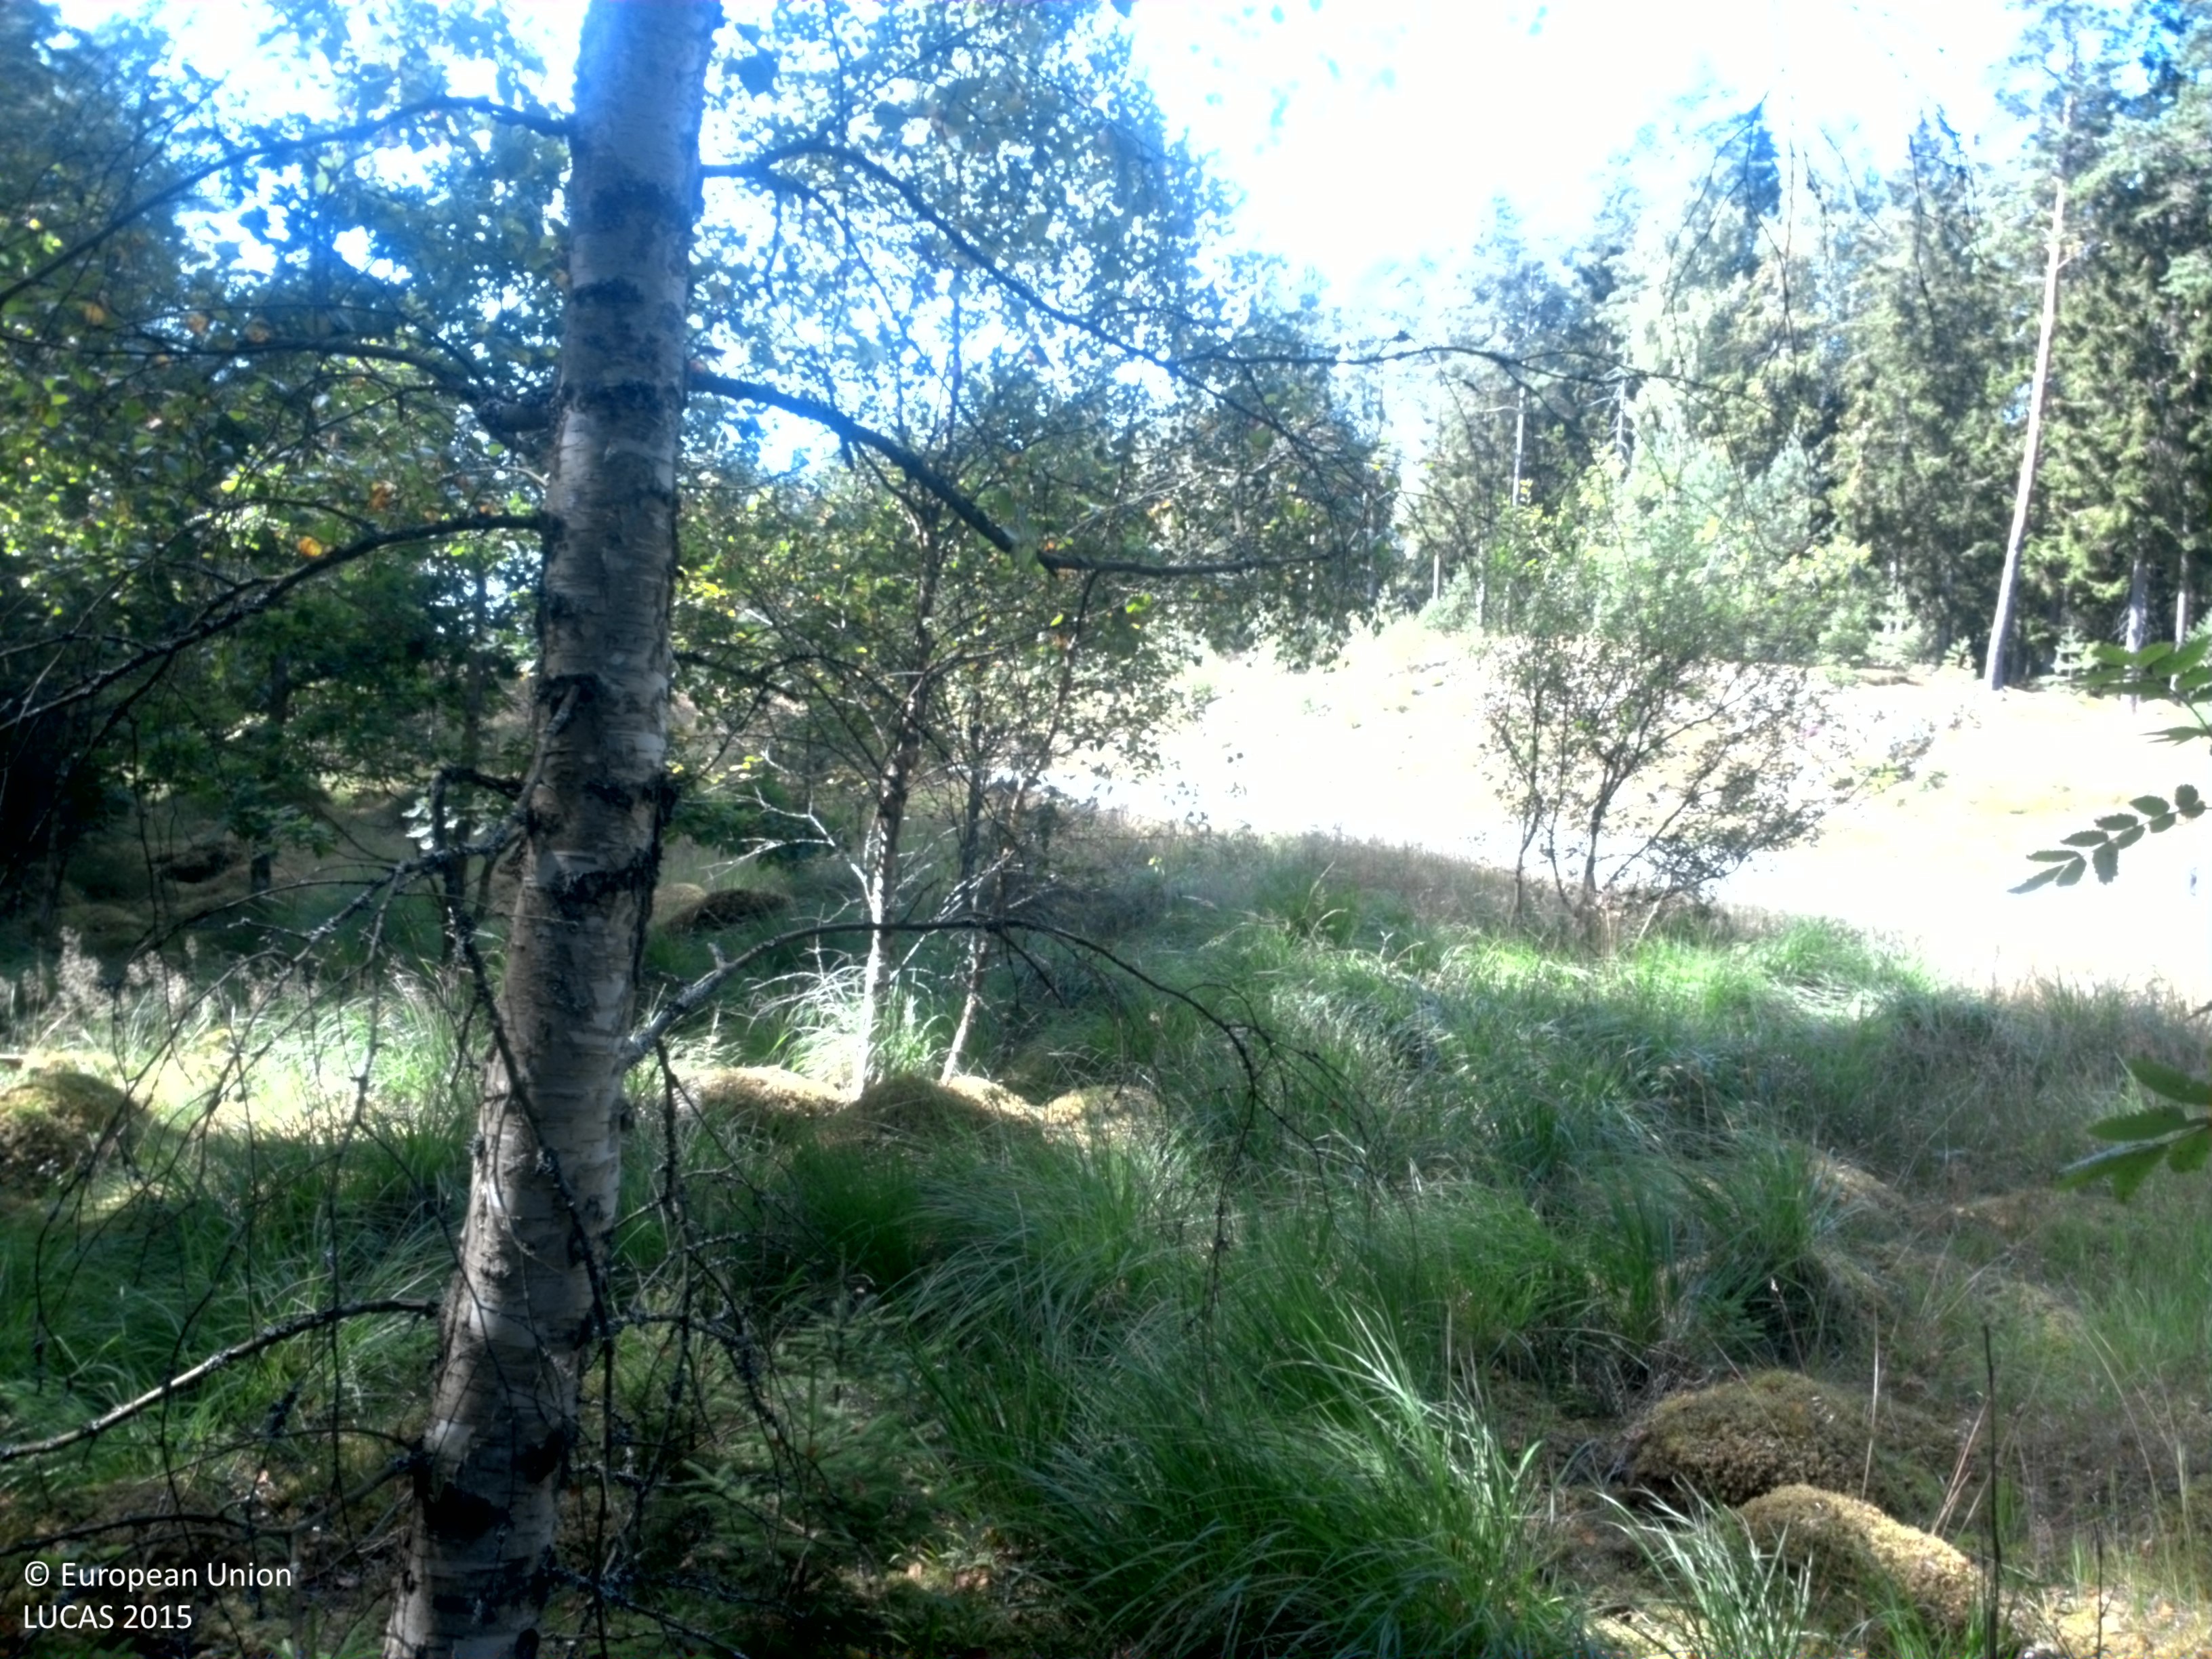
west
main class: Woodland
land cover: Pine dominated mixed woodland
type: boreal forest
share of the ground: 25 - 50 %
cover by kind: coniferous forest trees 30 %, herbaceous plants 30 %, lichens and mosses 25 %, broadleaved forest trees 15 %
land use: Forestry
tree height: > 5 m
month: August
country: SE
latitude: 58.0587
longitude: 13.0624
